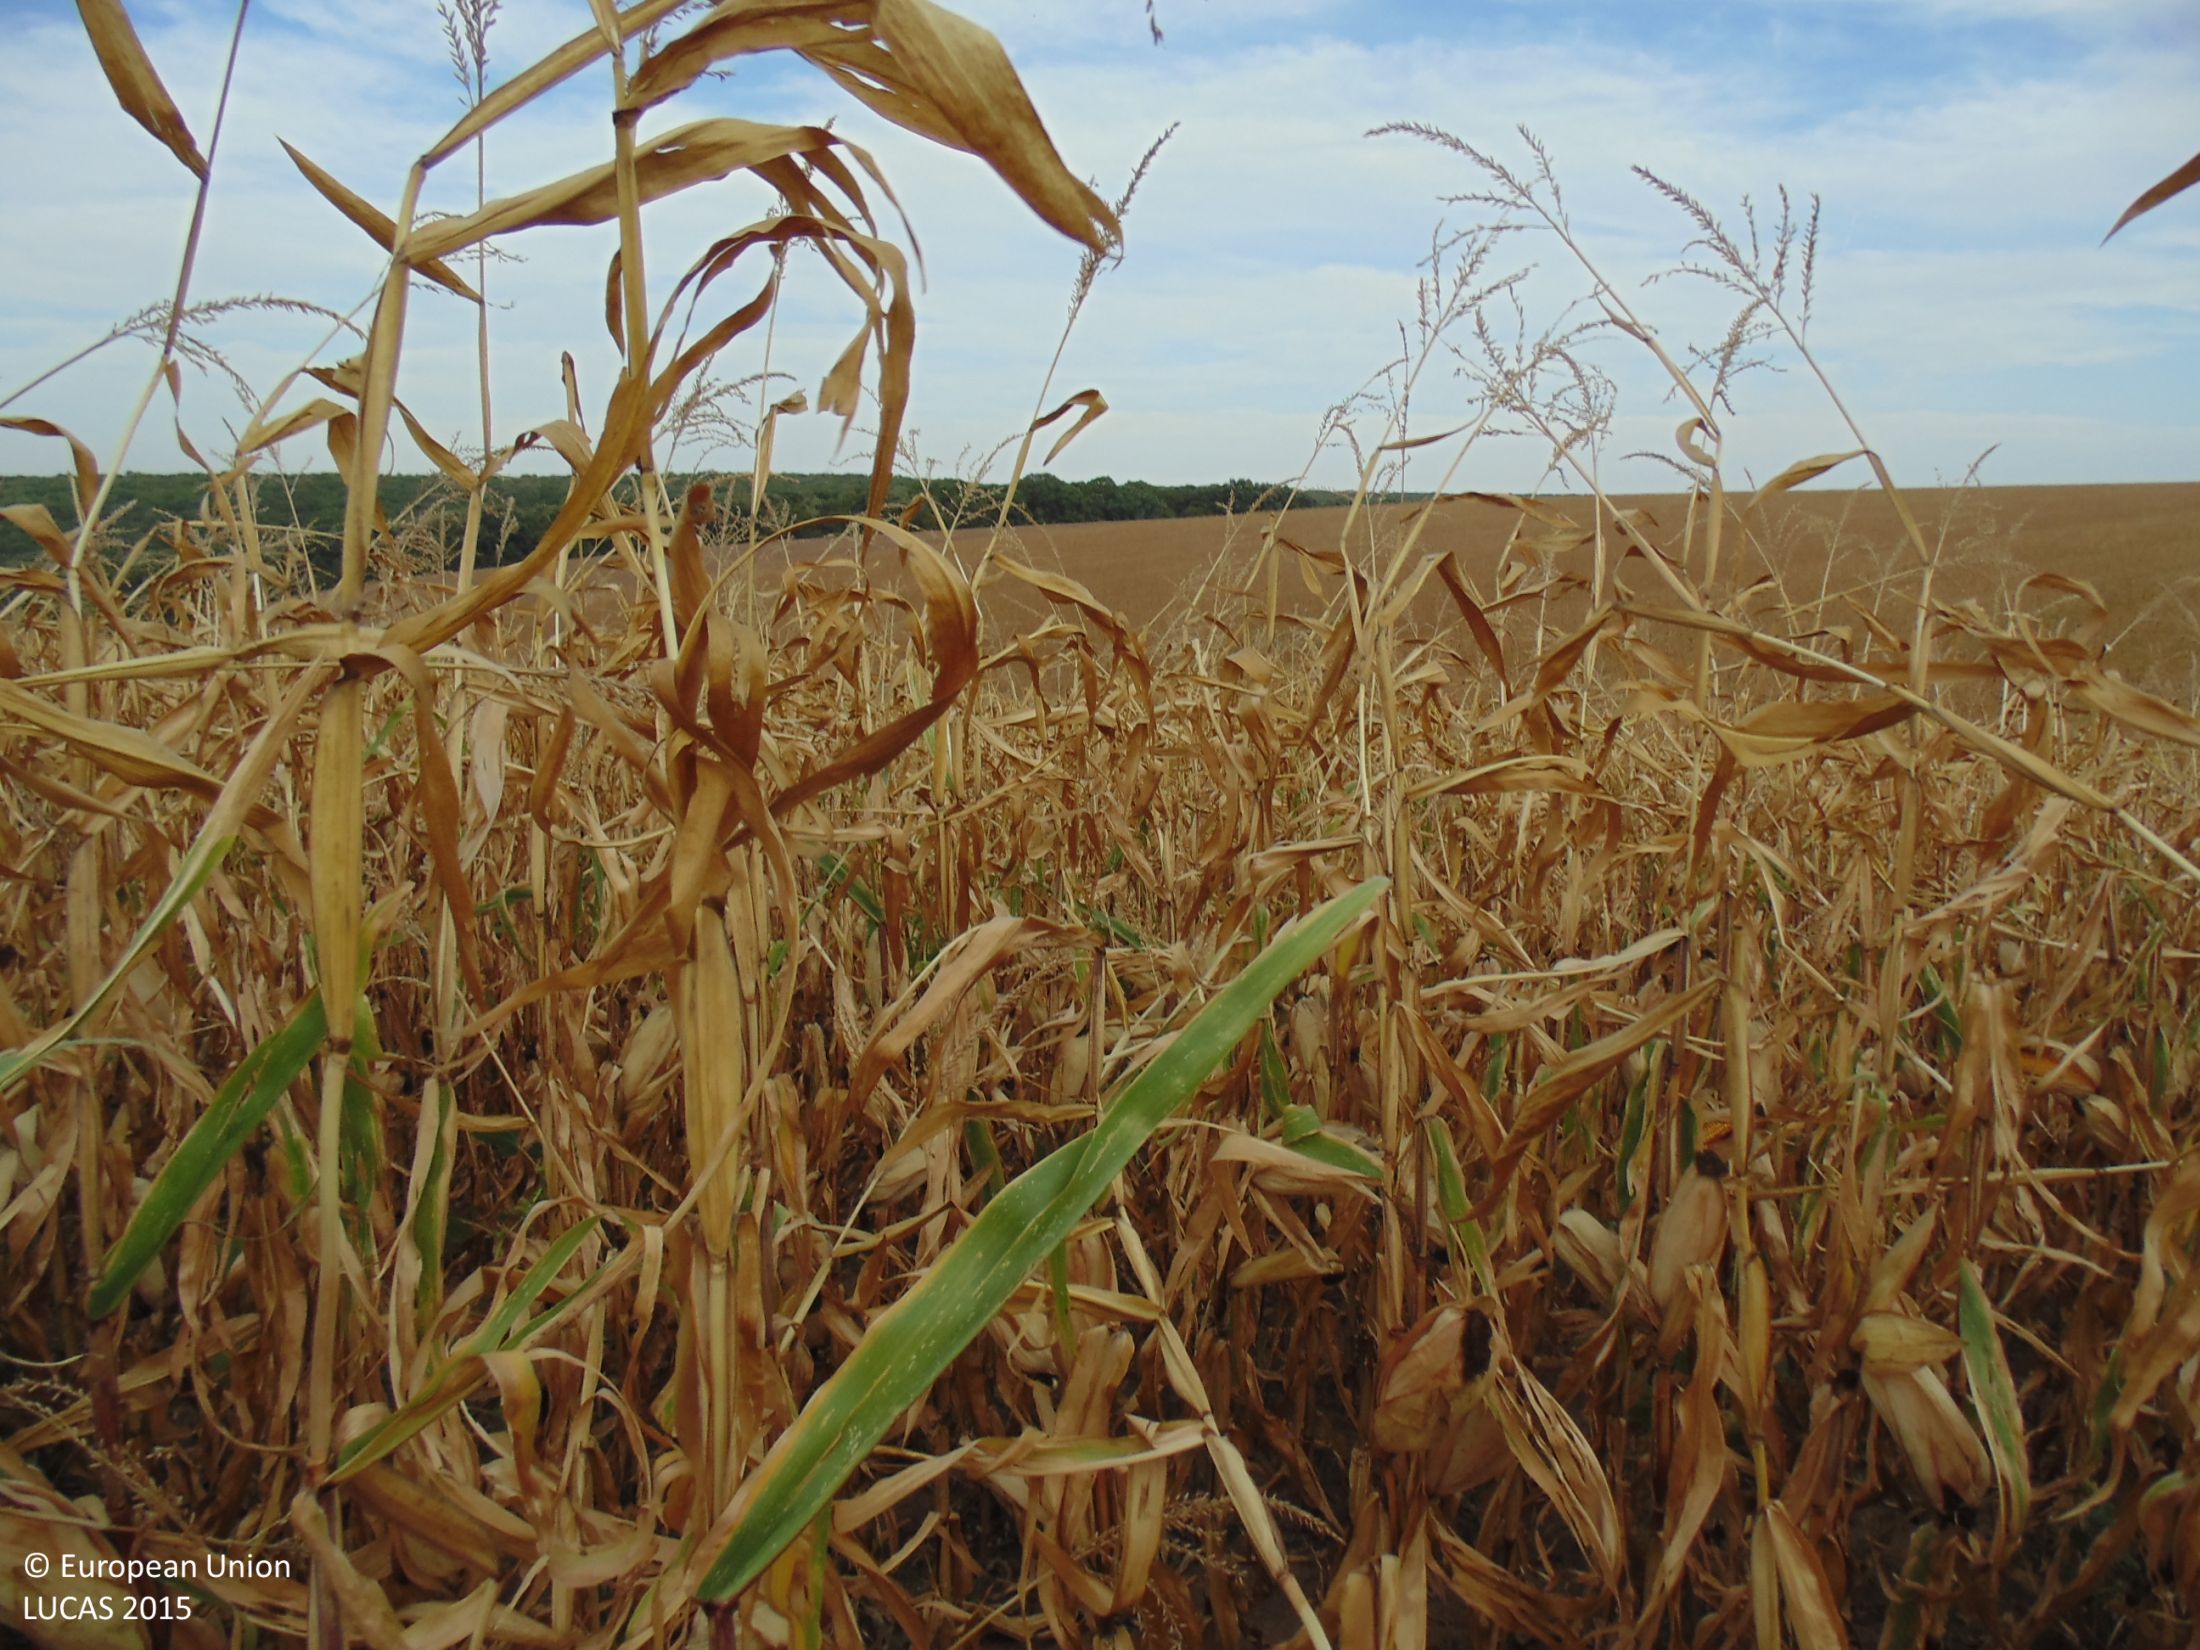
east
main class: Cropland
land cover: Maize
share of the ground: > 75 %
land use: Agriculture (excluding fallow land and kitchen gardens)
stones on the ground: < 10 %
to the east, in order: Maize; Tracks; Maize
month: September
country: BG
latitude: 43.9218
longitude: 27.1518
